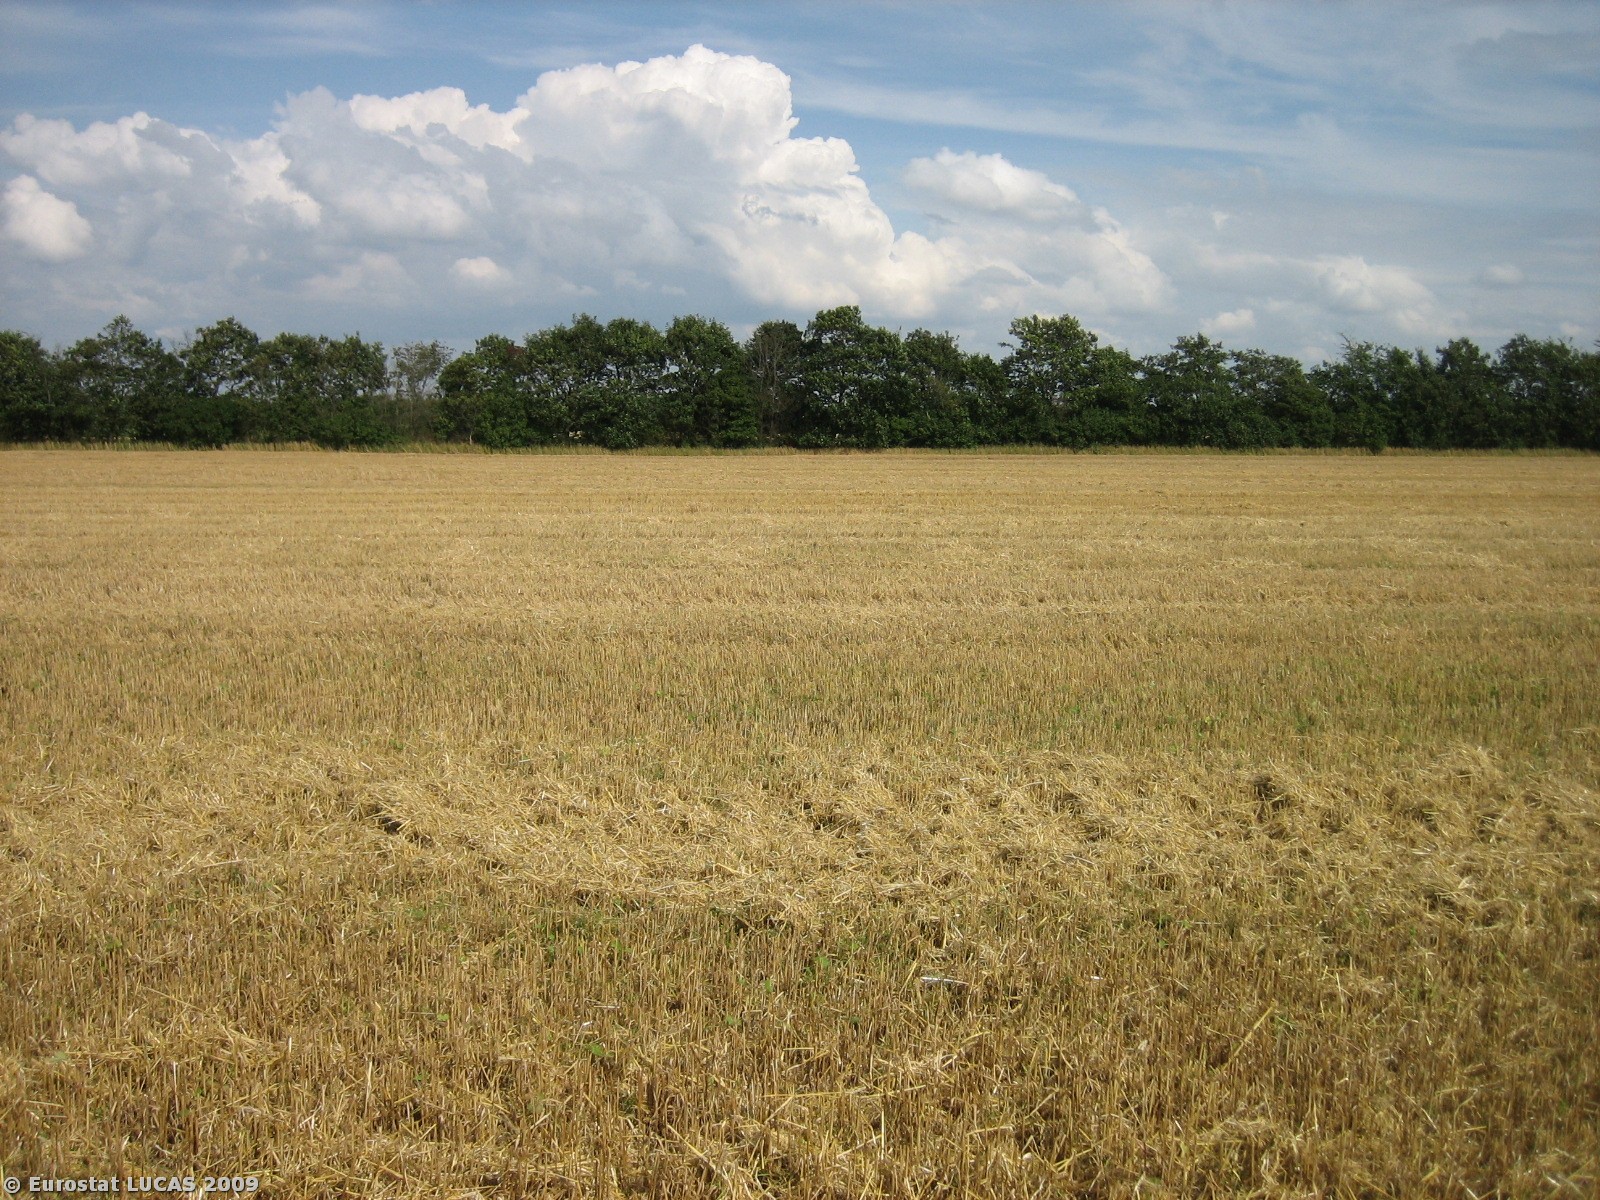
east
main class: Cropland
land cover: Barley
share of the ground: > 75 %
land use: Agriculture (excluding fallow land and kitchen gardens)
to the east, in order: Barley; Broadleaved woodland; Barley
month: July
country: DK
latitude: 55.7687
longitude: 8.8057
